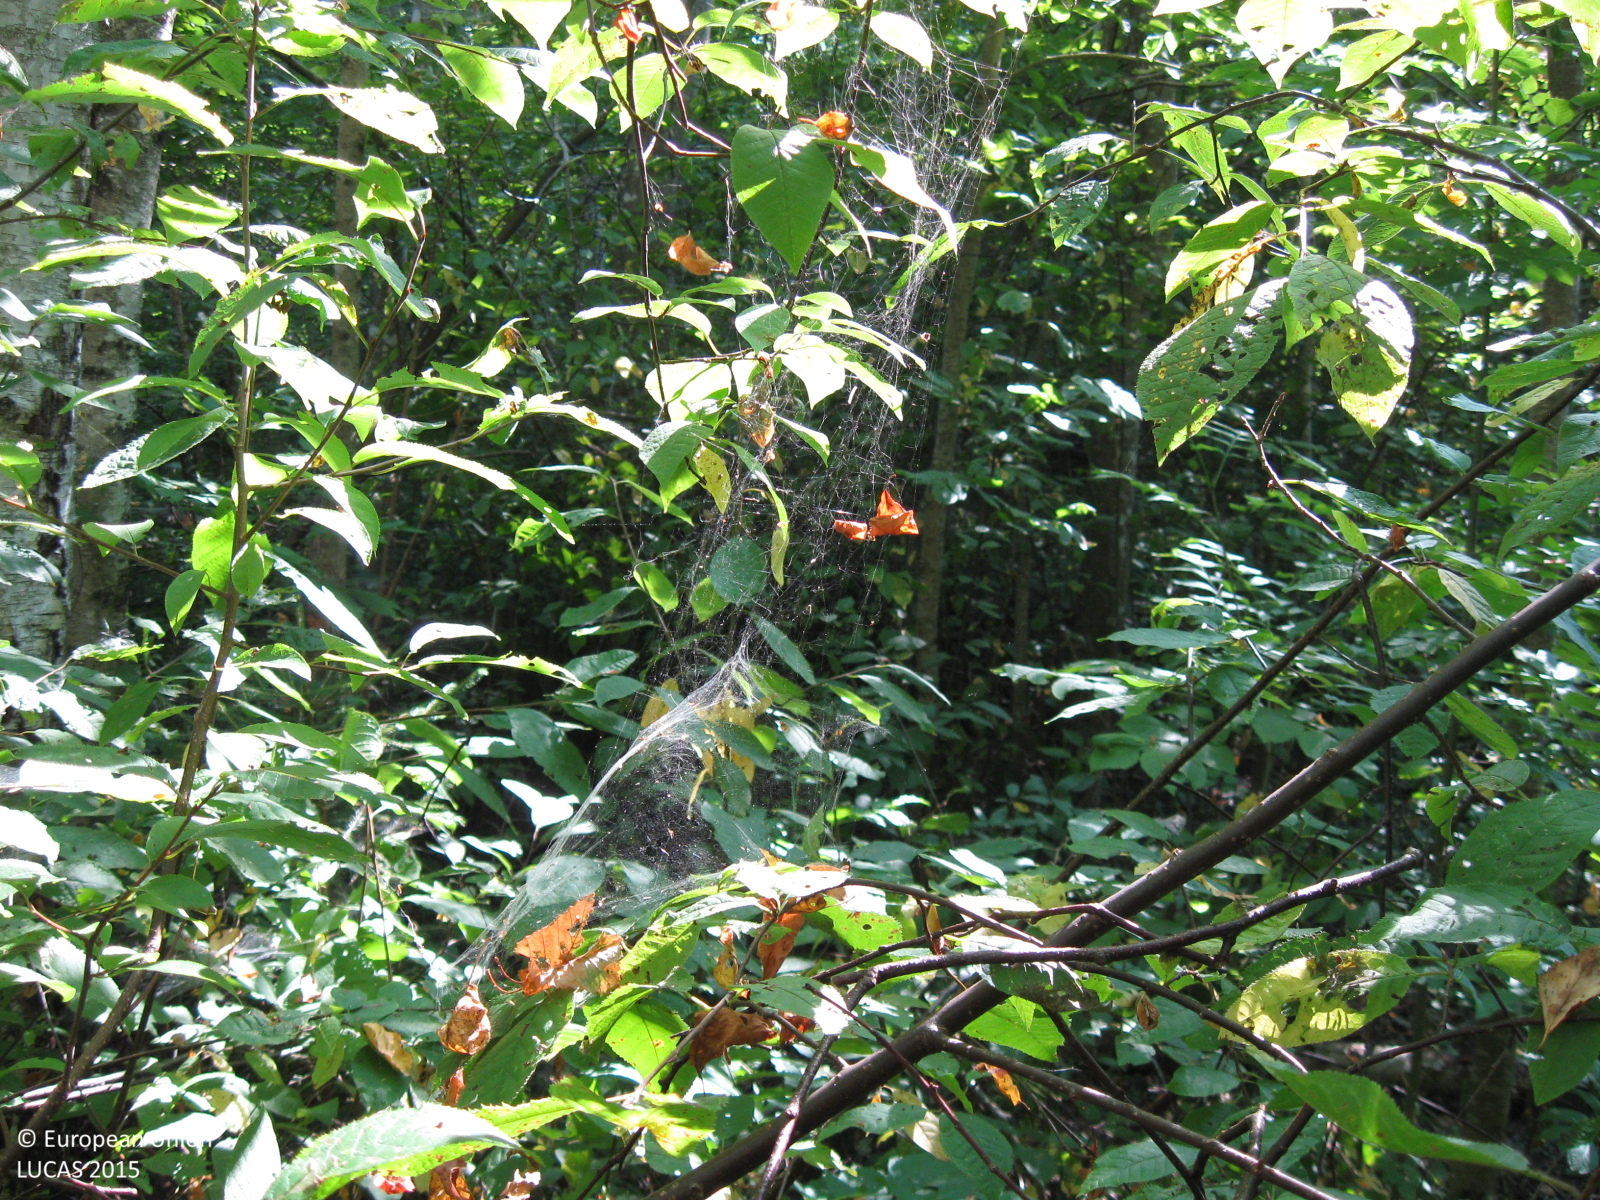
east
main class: Woodland
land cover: Broadleaved woodland
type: non-riverine alder, birch or aspen forest
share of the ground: > 75 %
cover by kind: broadleaved forest trees 95 %, herbaceous plants 5 %
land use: Forestry
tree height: > 5 m
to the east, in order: Broadleaved woodland
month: August
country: LT
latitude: 55.4929
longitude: 22.9366
